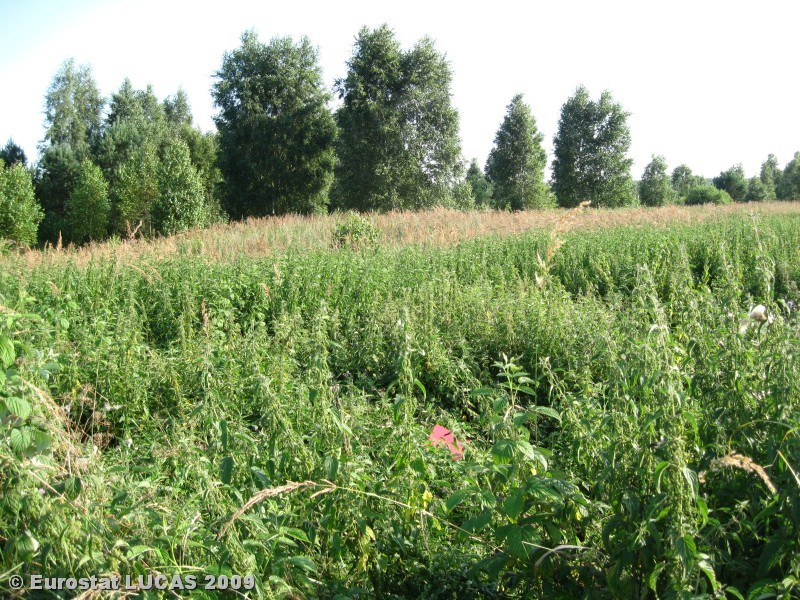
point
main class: Grassland
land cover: Spontaneously vegetated surfaces
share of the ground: > 75 %
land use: Unused
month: August
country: LT
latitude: 54.8326
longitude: 23.4850
